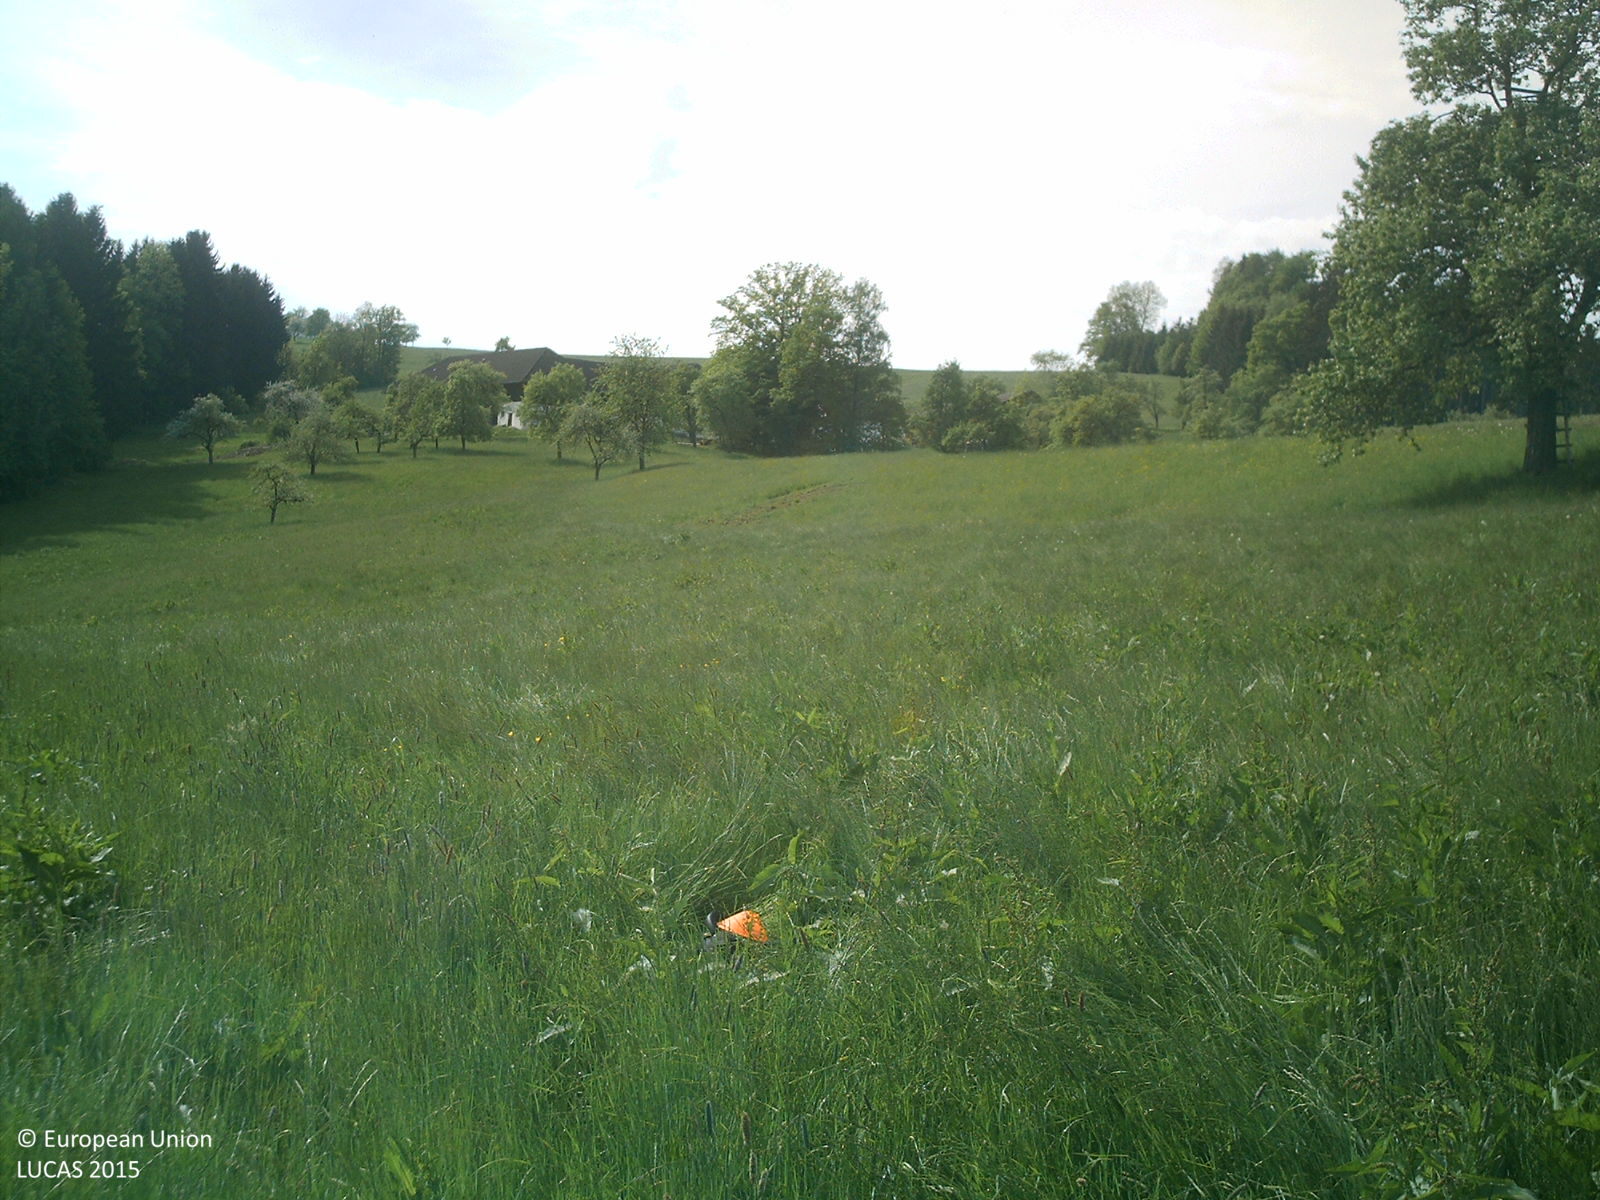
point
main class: Grassland
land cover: Grassland without tree/shrub cover
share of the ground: > 75 %
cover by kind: herbaceous plants 100 %
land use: Agriculture (excluding fallow land and kitchen gardens)
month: May
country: AT
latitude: 47.9498
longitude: 14.0833
